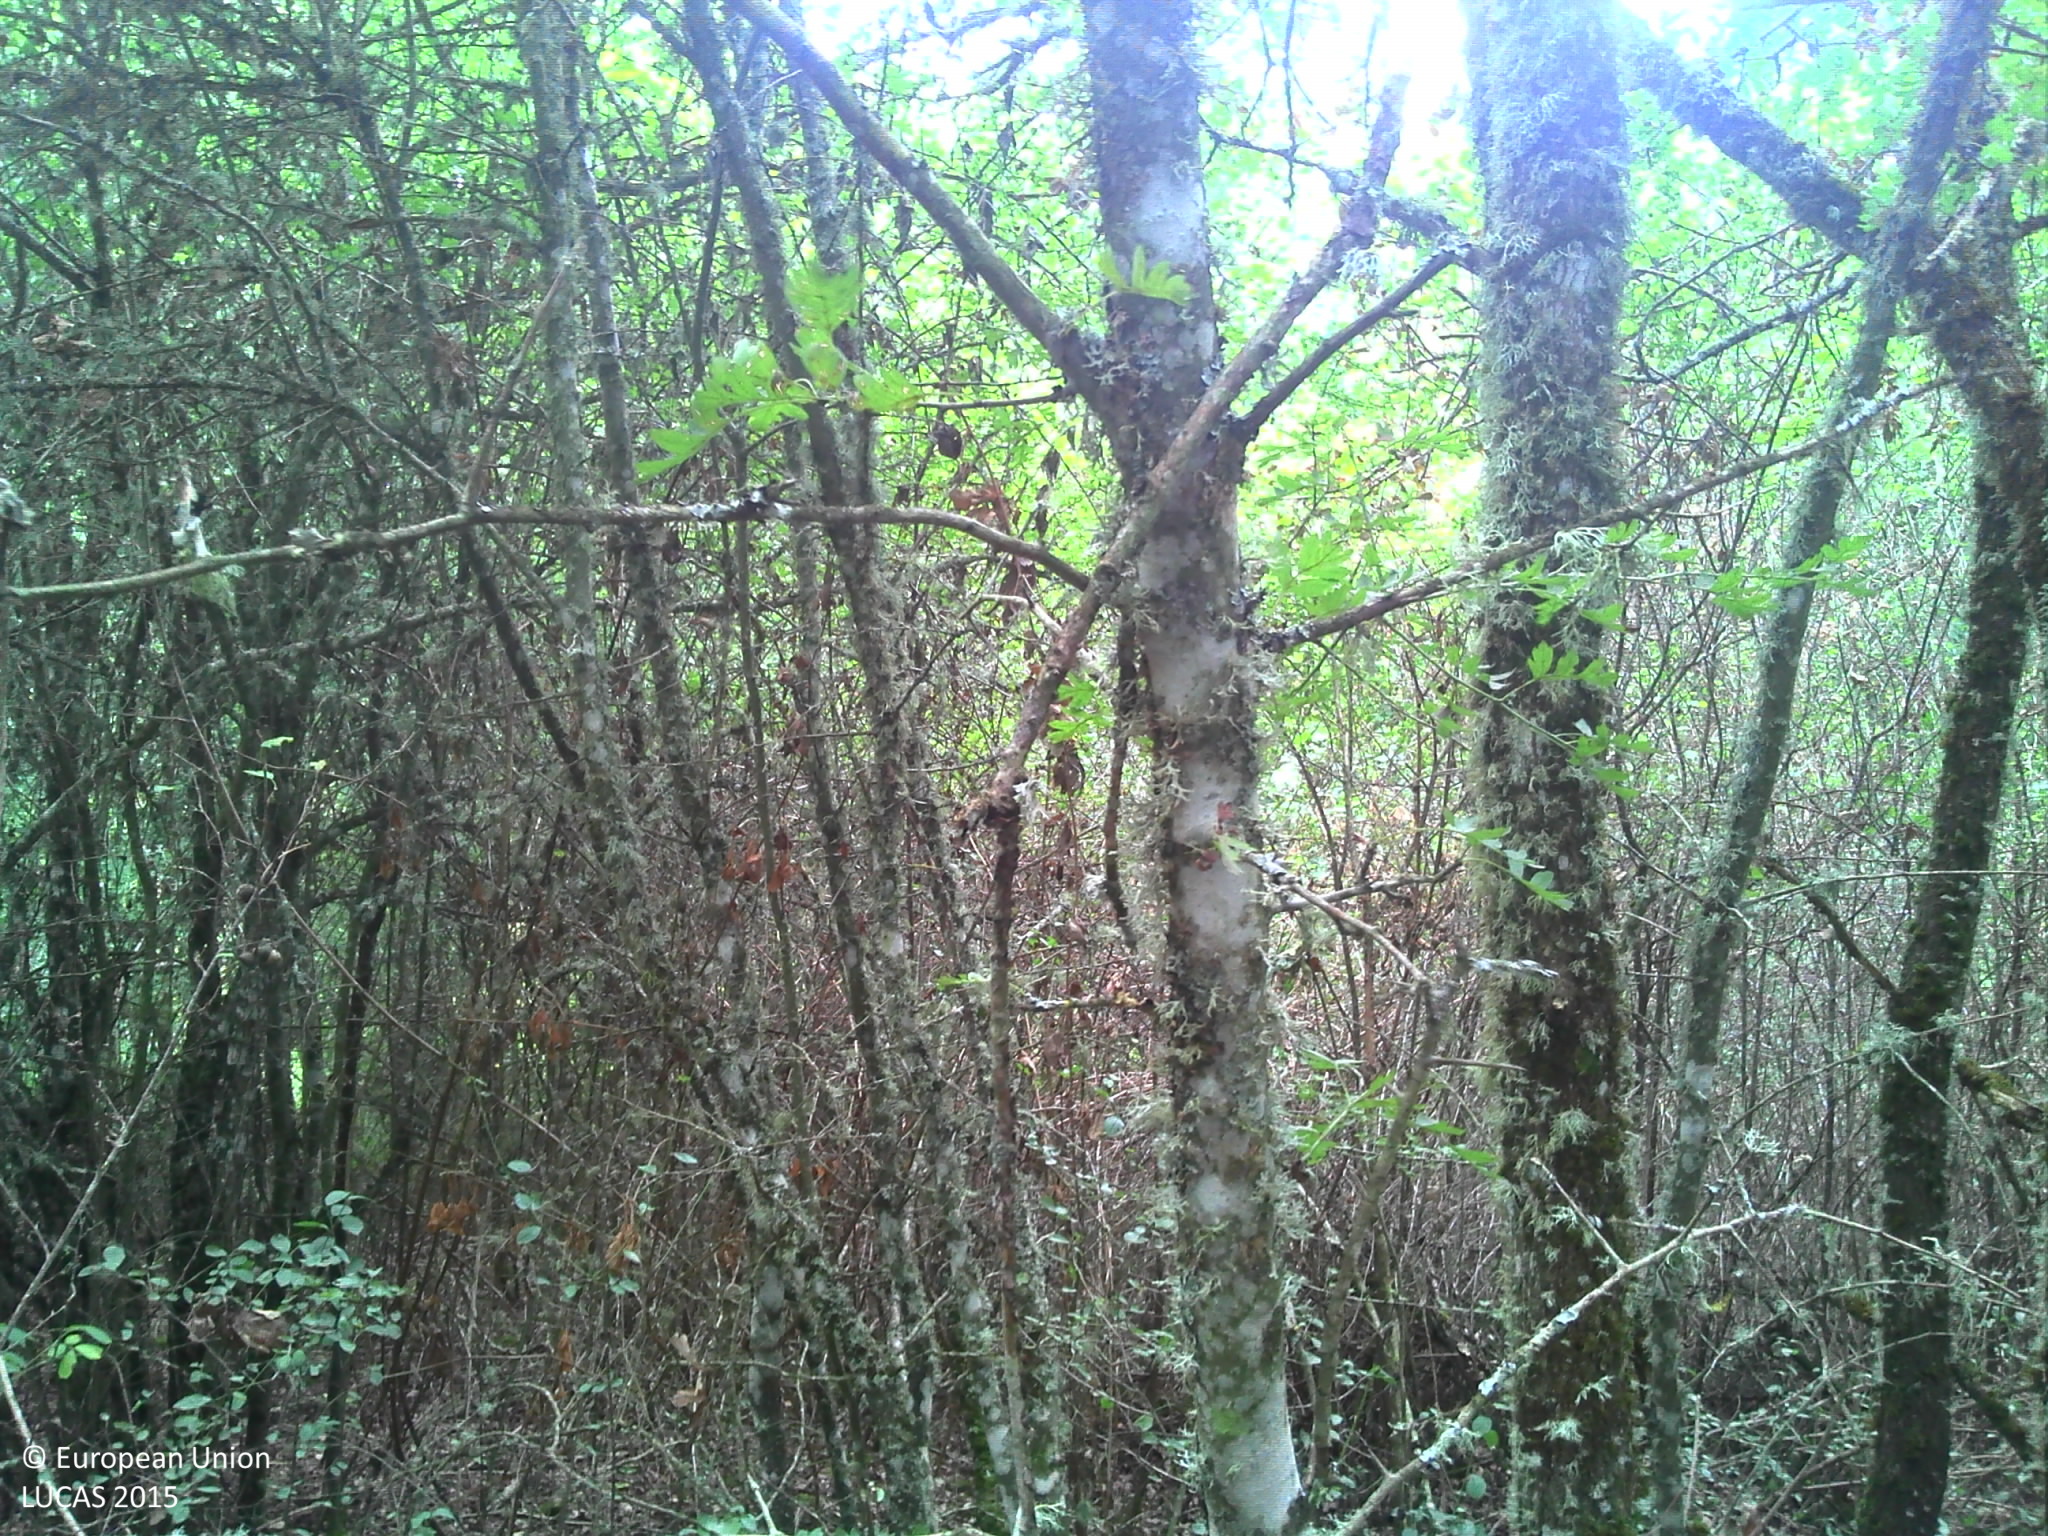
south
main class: Woodland
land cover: Broadleaved woodland
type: acidophilous oak and oak-birch forest
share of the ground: > 75 %
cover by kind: broadleaved forest trees 80 %, shrubs 10 %, herbaceous plants 10 %
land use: Forestry
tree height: > 5 m
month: August
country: FR
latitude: 46.0001
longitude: 2.2870
